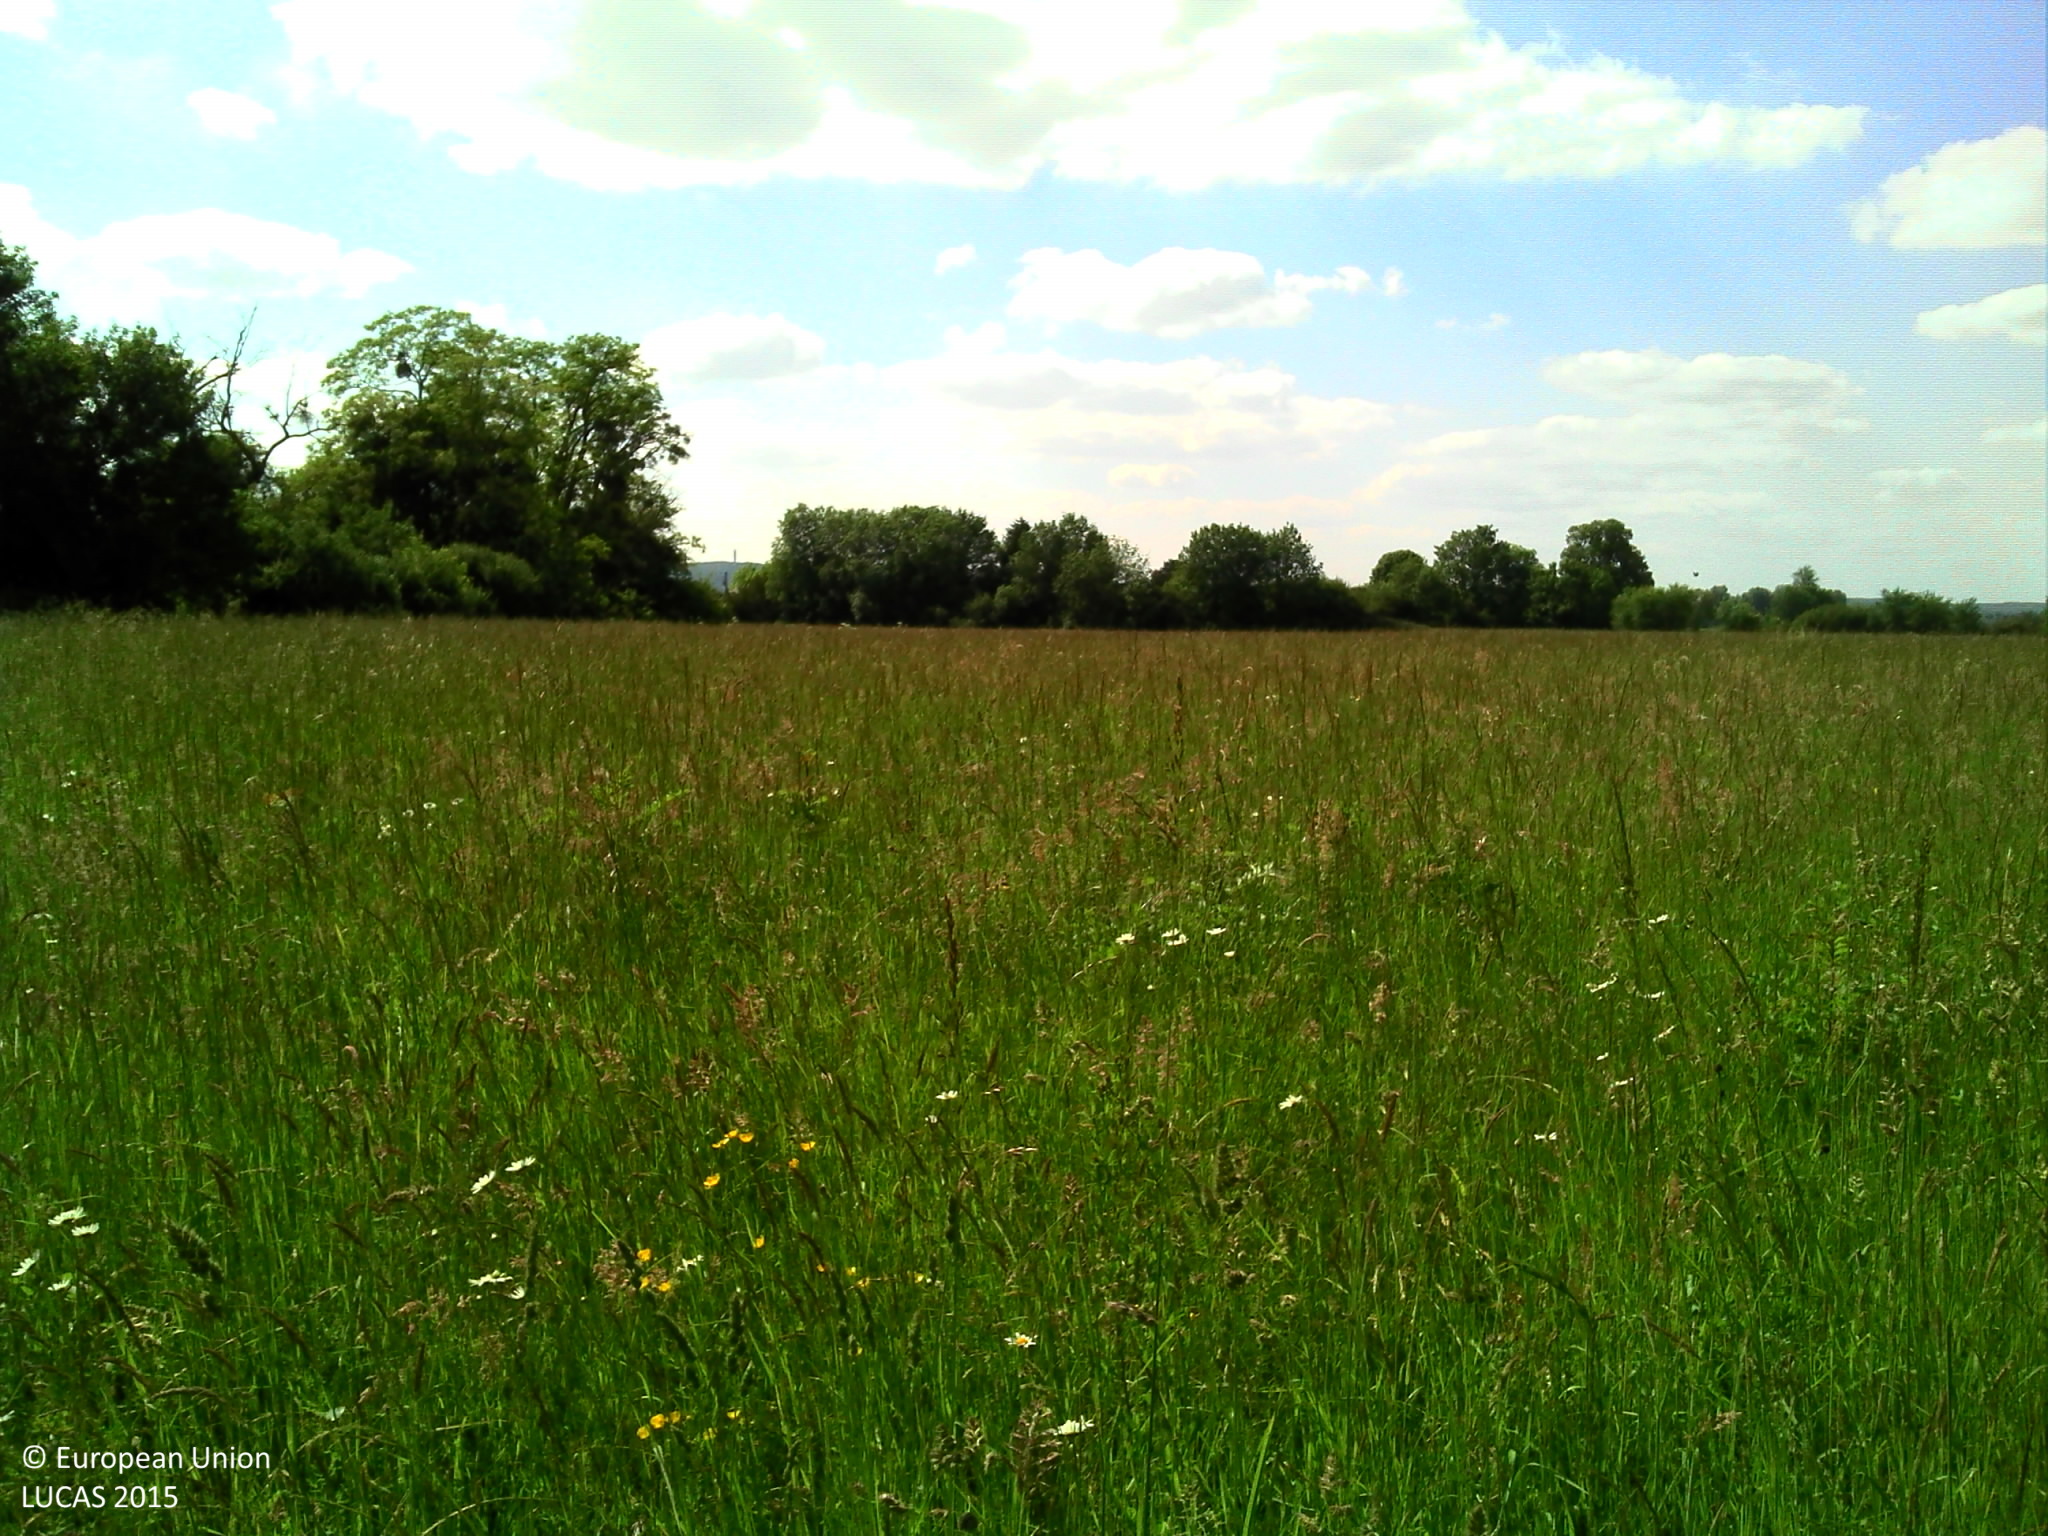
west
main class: Grassland
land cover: Grassland without tree/shrub cover
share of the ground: > 75 %
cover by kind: herbaceous plants 100 %
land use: Agriculture (excluding fallow land and kitchen gardens)
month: May
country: FR
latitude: 47.2912
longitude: 2.9202
